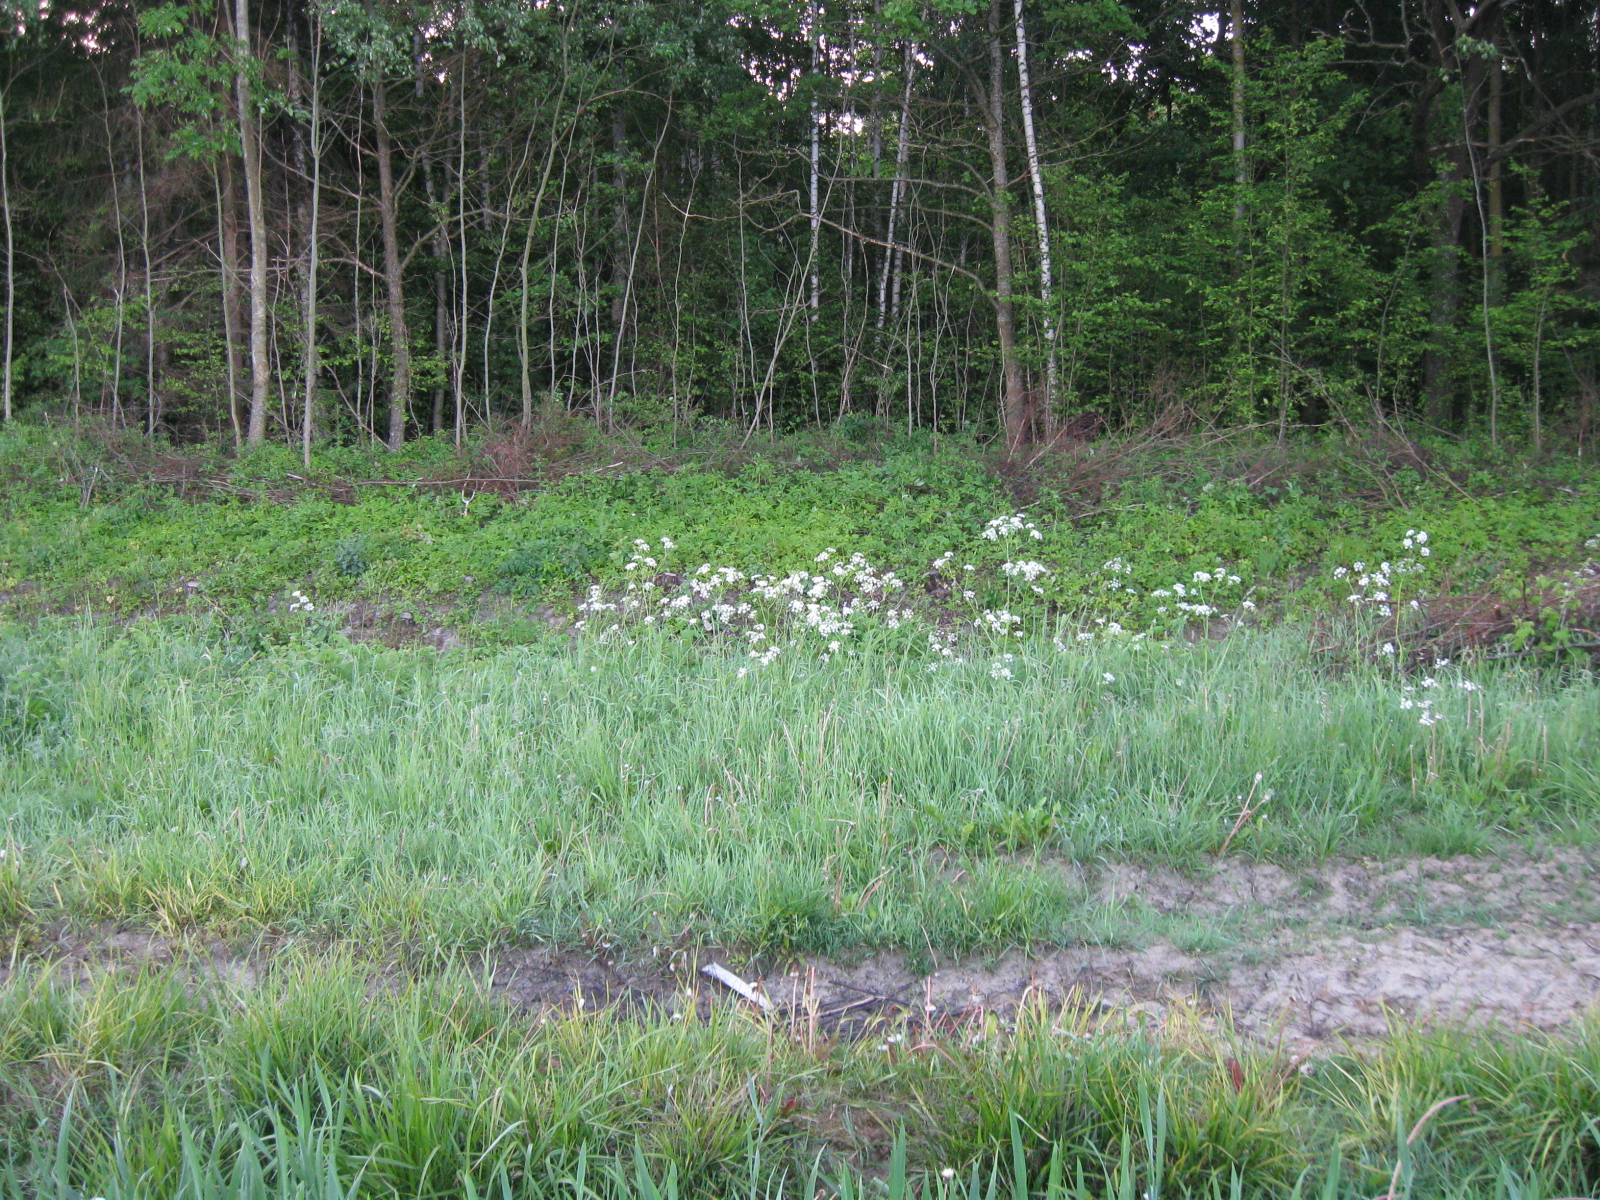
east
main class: Cropland
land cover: Common wheat
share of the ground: > 75 %
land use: Agriculture (excluding fallow land and kitchen gardens)
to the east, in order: Common wheat; Grass margins; Tracks; Spontaneously vegetated surfaces; Ditches and canals; Spontaneously vegetated surfaces; Other mixed woodland
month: June
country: LT
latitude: 54.4685
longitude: 23.8049
